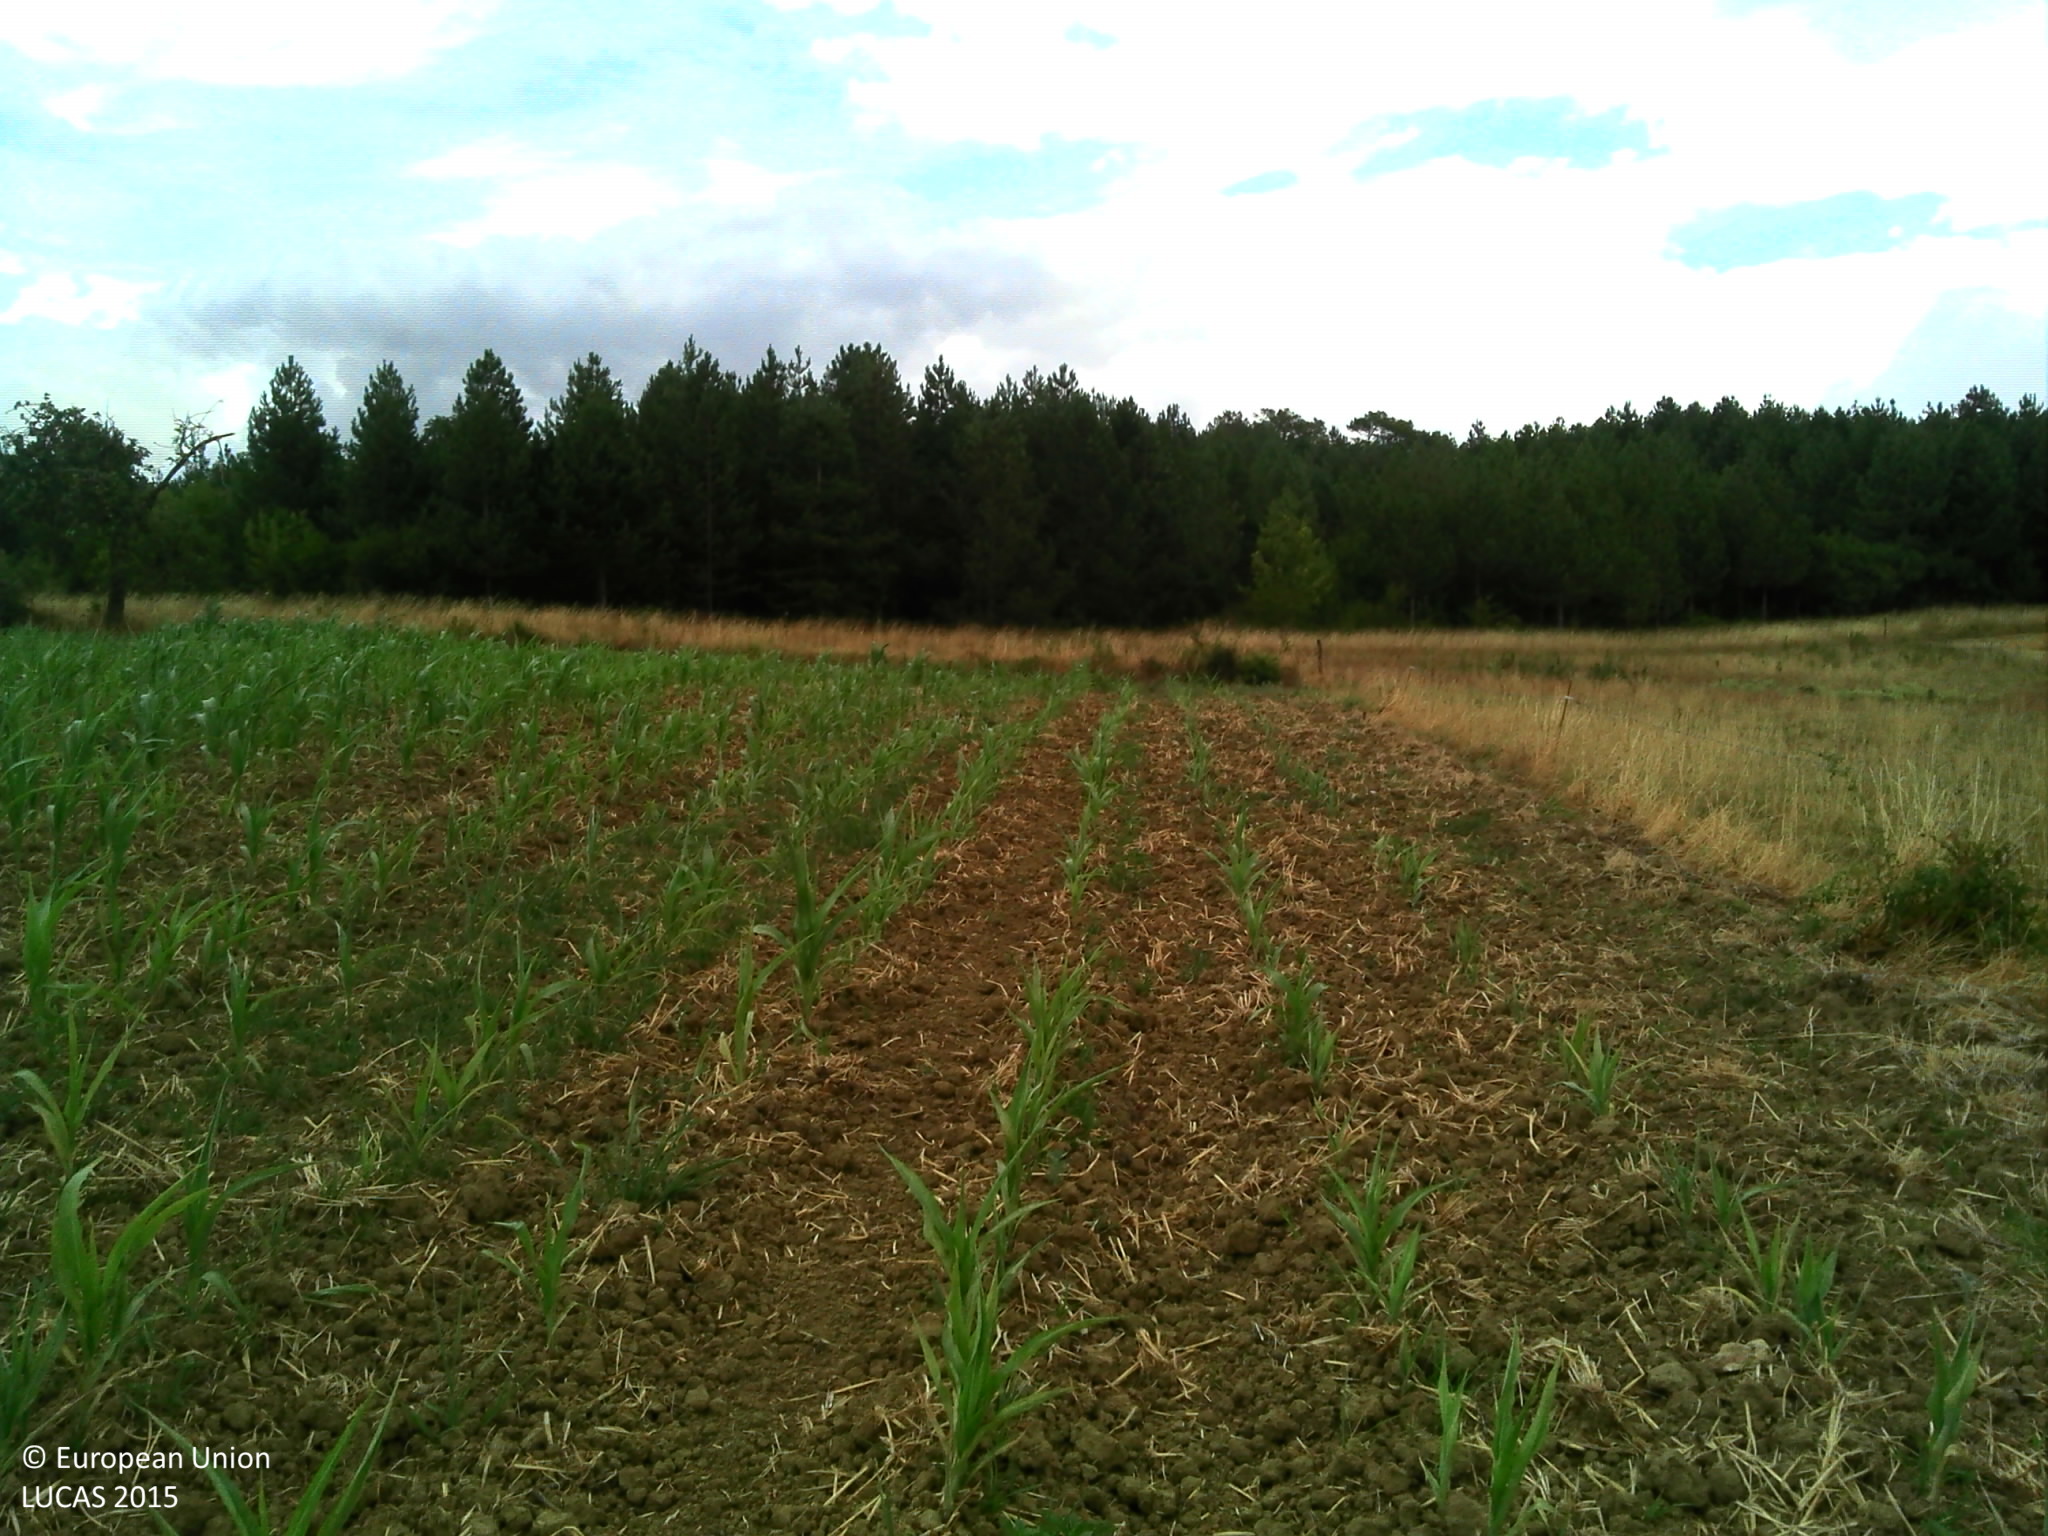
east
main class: Cropland
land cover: Maize
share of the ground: 10 - 25 %
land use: Agriculture (excluding fallow land and kitchen gardens)
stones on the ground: < 10 %
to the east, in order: Maize; Fences; Grassland without tree/shrub cover; Fences; Spontaneously vegetated surfaces; Pine dominated mixed woodland; Broadleaved woodland
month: July
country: FR
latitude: 44.4632
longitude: 0.5534
